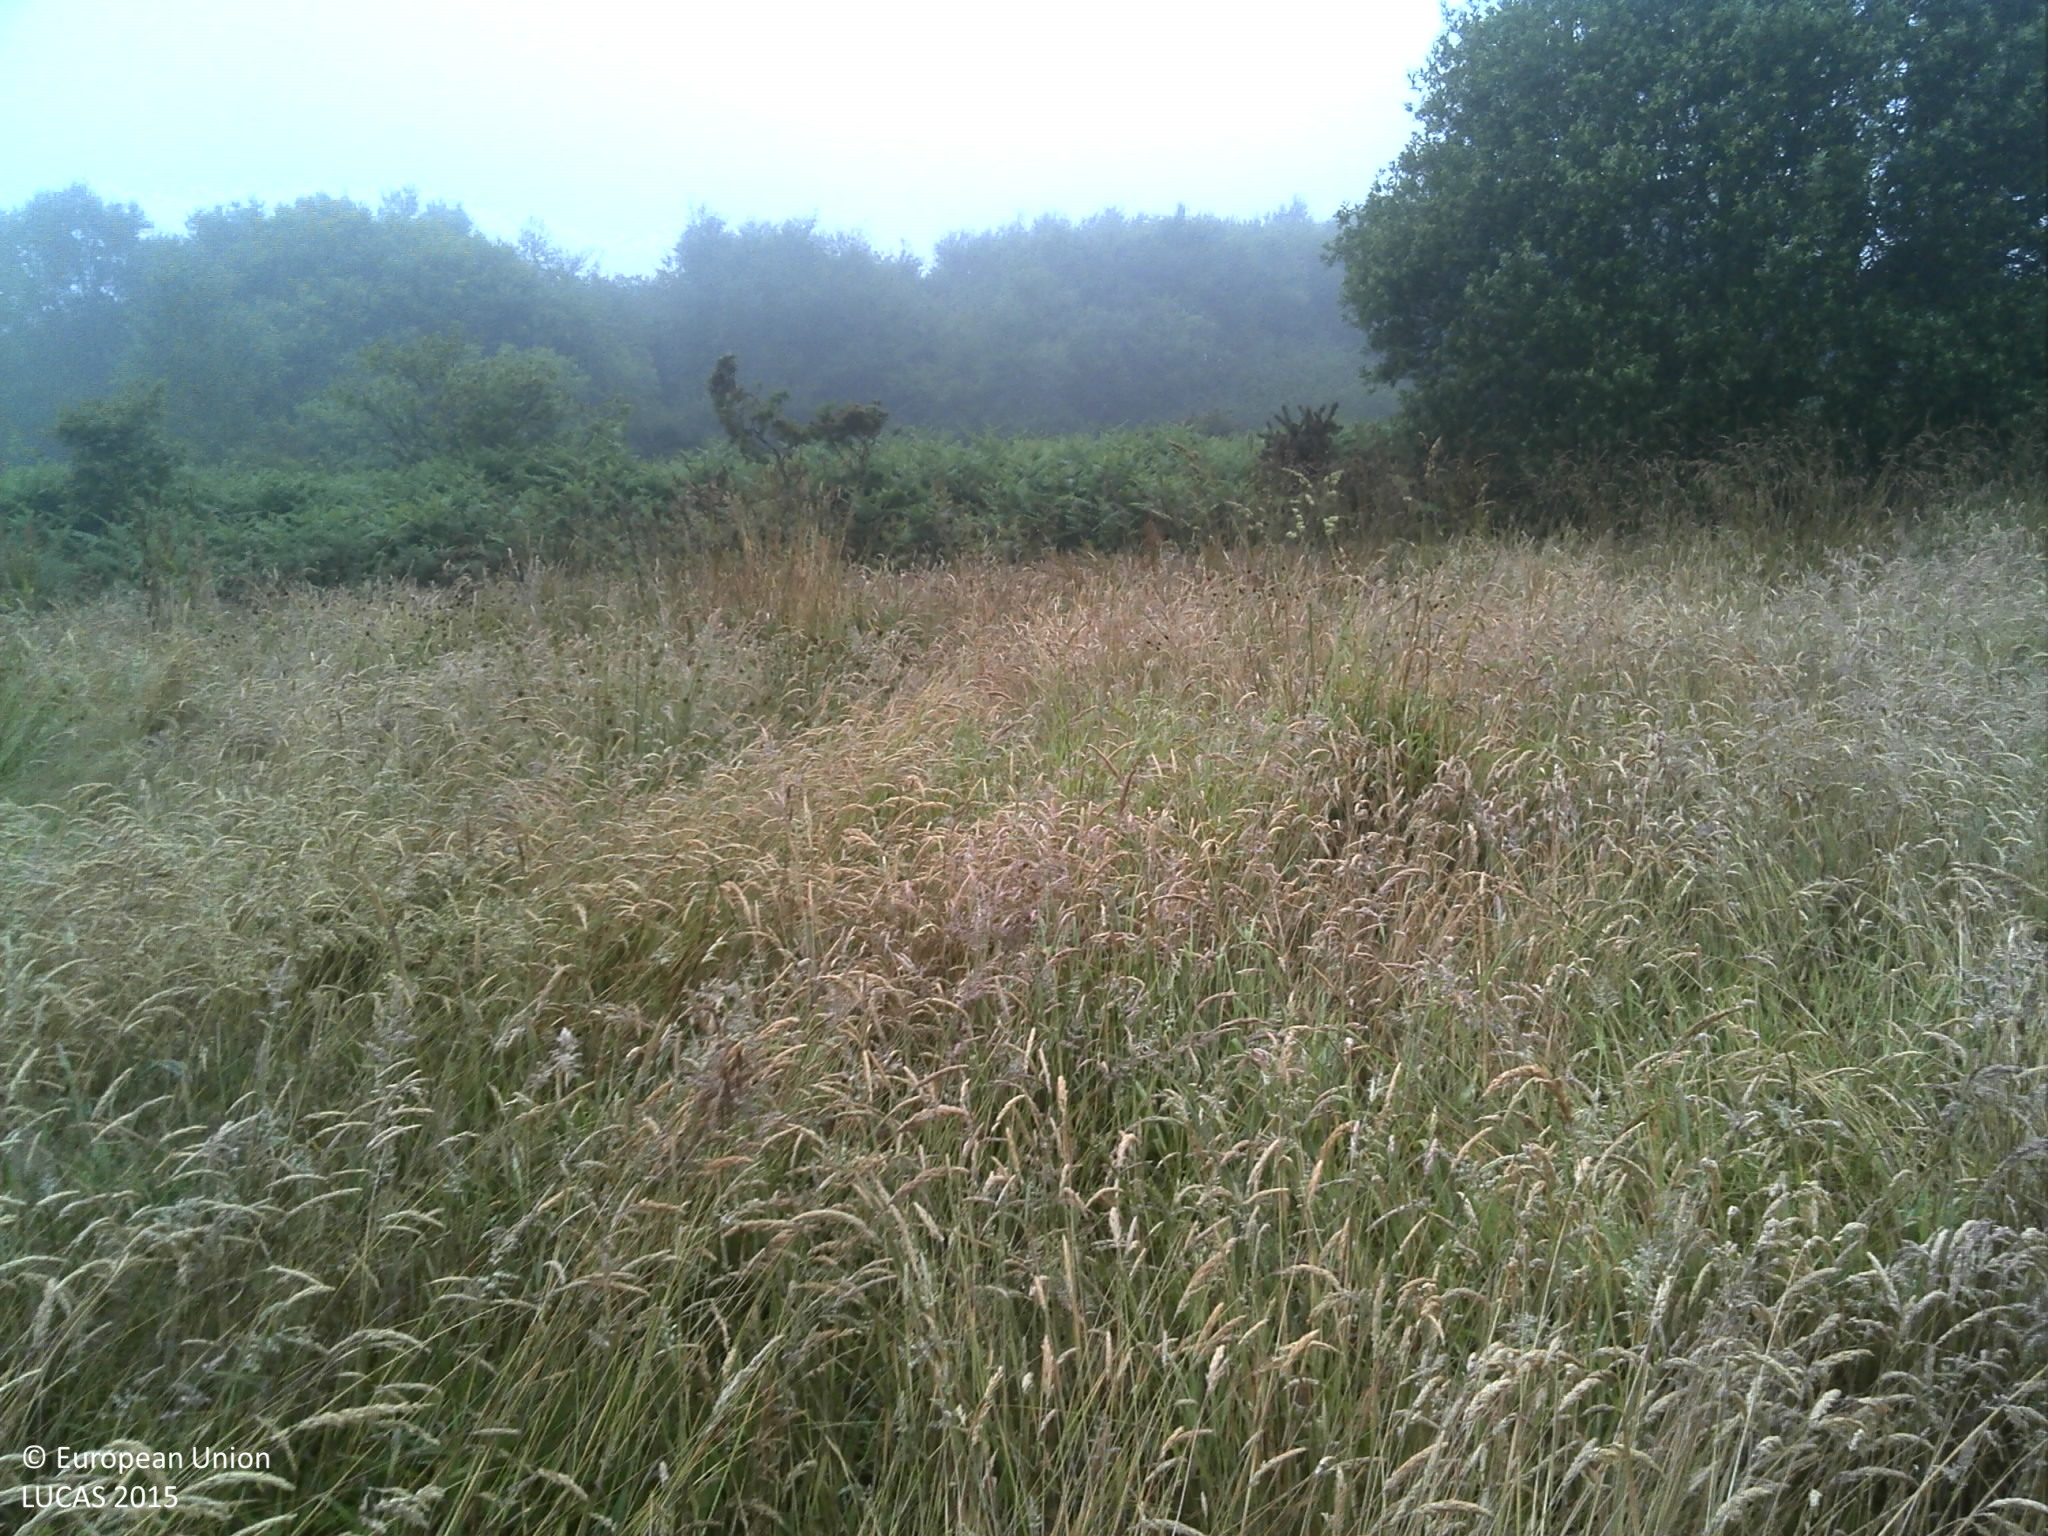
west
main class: Grassland
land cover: Grassland without tree/shrub cover
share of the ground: > 75 %
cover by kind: herbaceous plants 100 %
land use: Agriculture (excluding fallow land and kitchen gardens)
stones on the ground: < 10 %
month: July
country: FR
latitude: 48.2073
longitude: -4.2348
